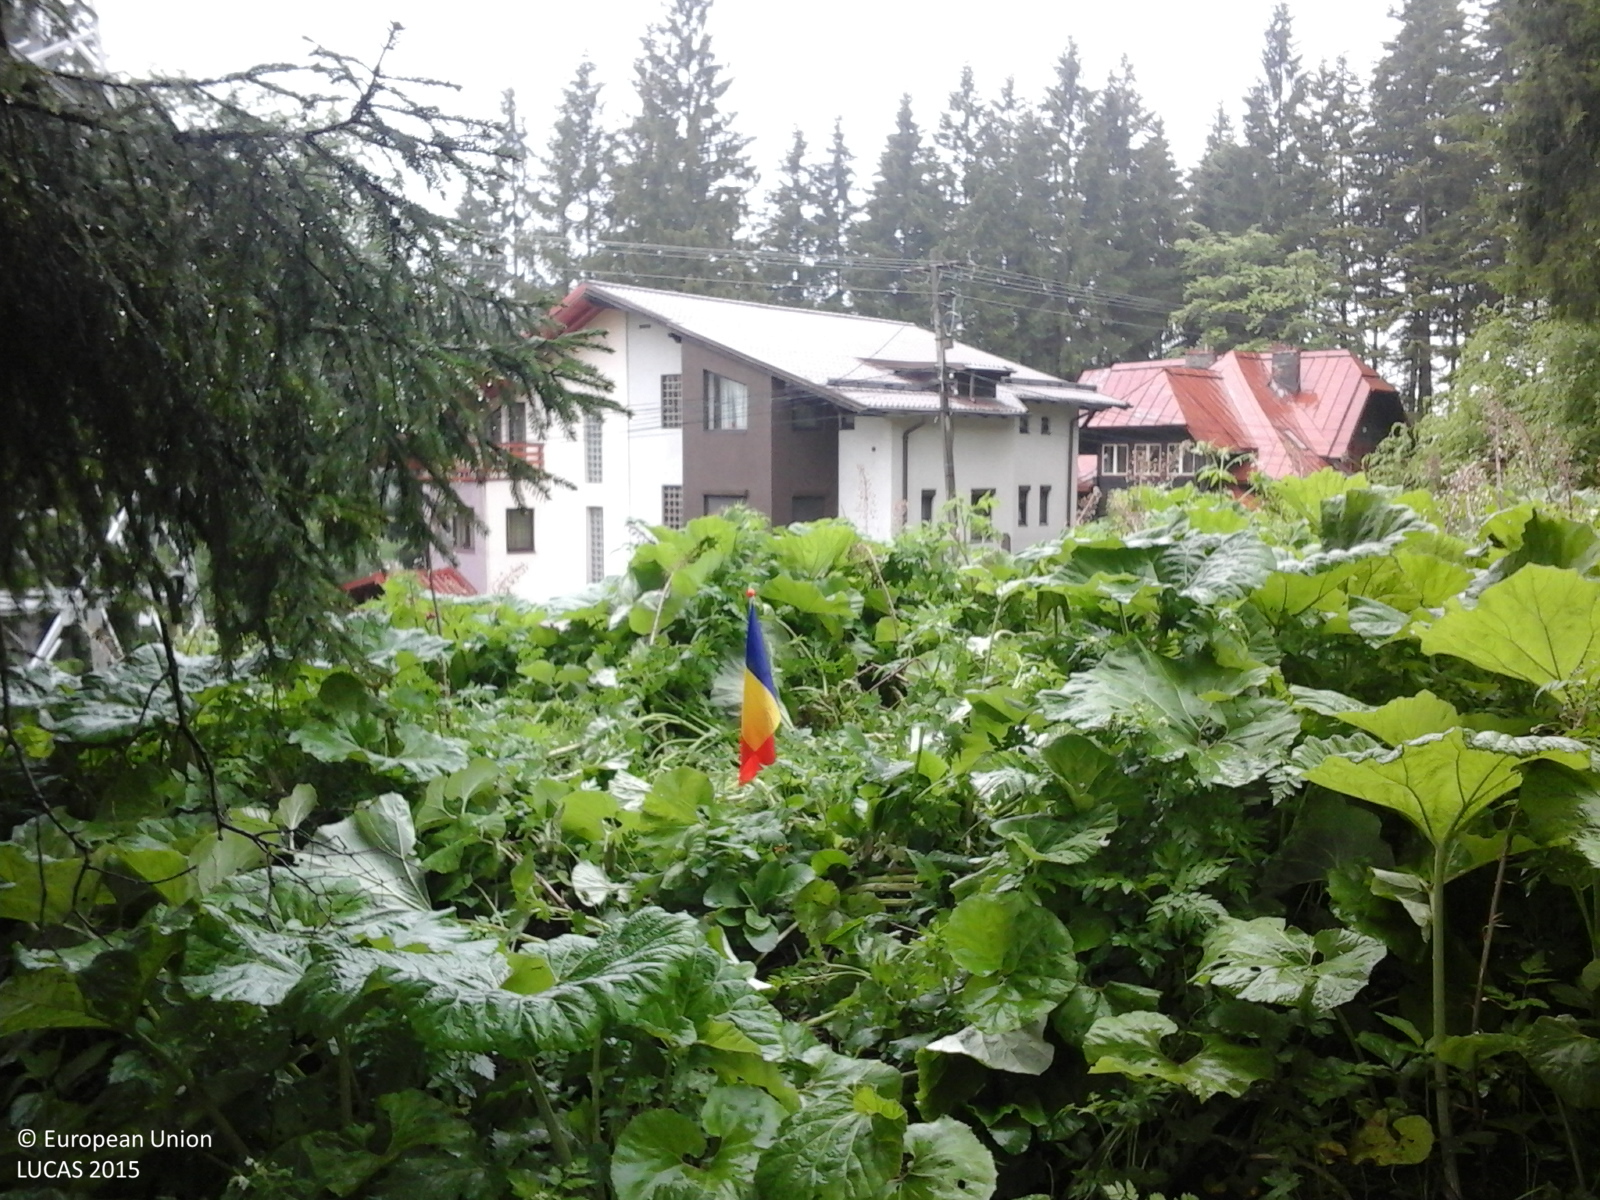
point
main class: Woodland
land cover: Spruce dominated coniferous woodland
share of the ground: > 75 %
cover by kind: coniferous forest trees 80 %, herbaceous plants 20 %
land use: Forestry
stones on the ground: < 10 %
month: May
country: RO
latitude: 45.4950
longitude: 25.5735
